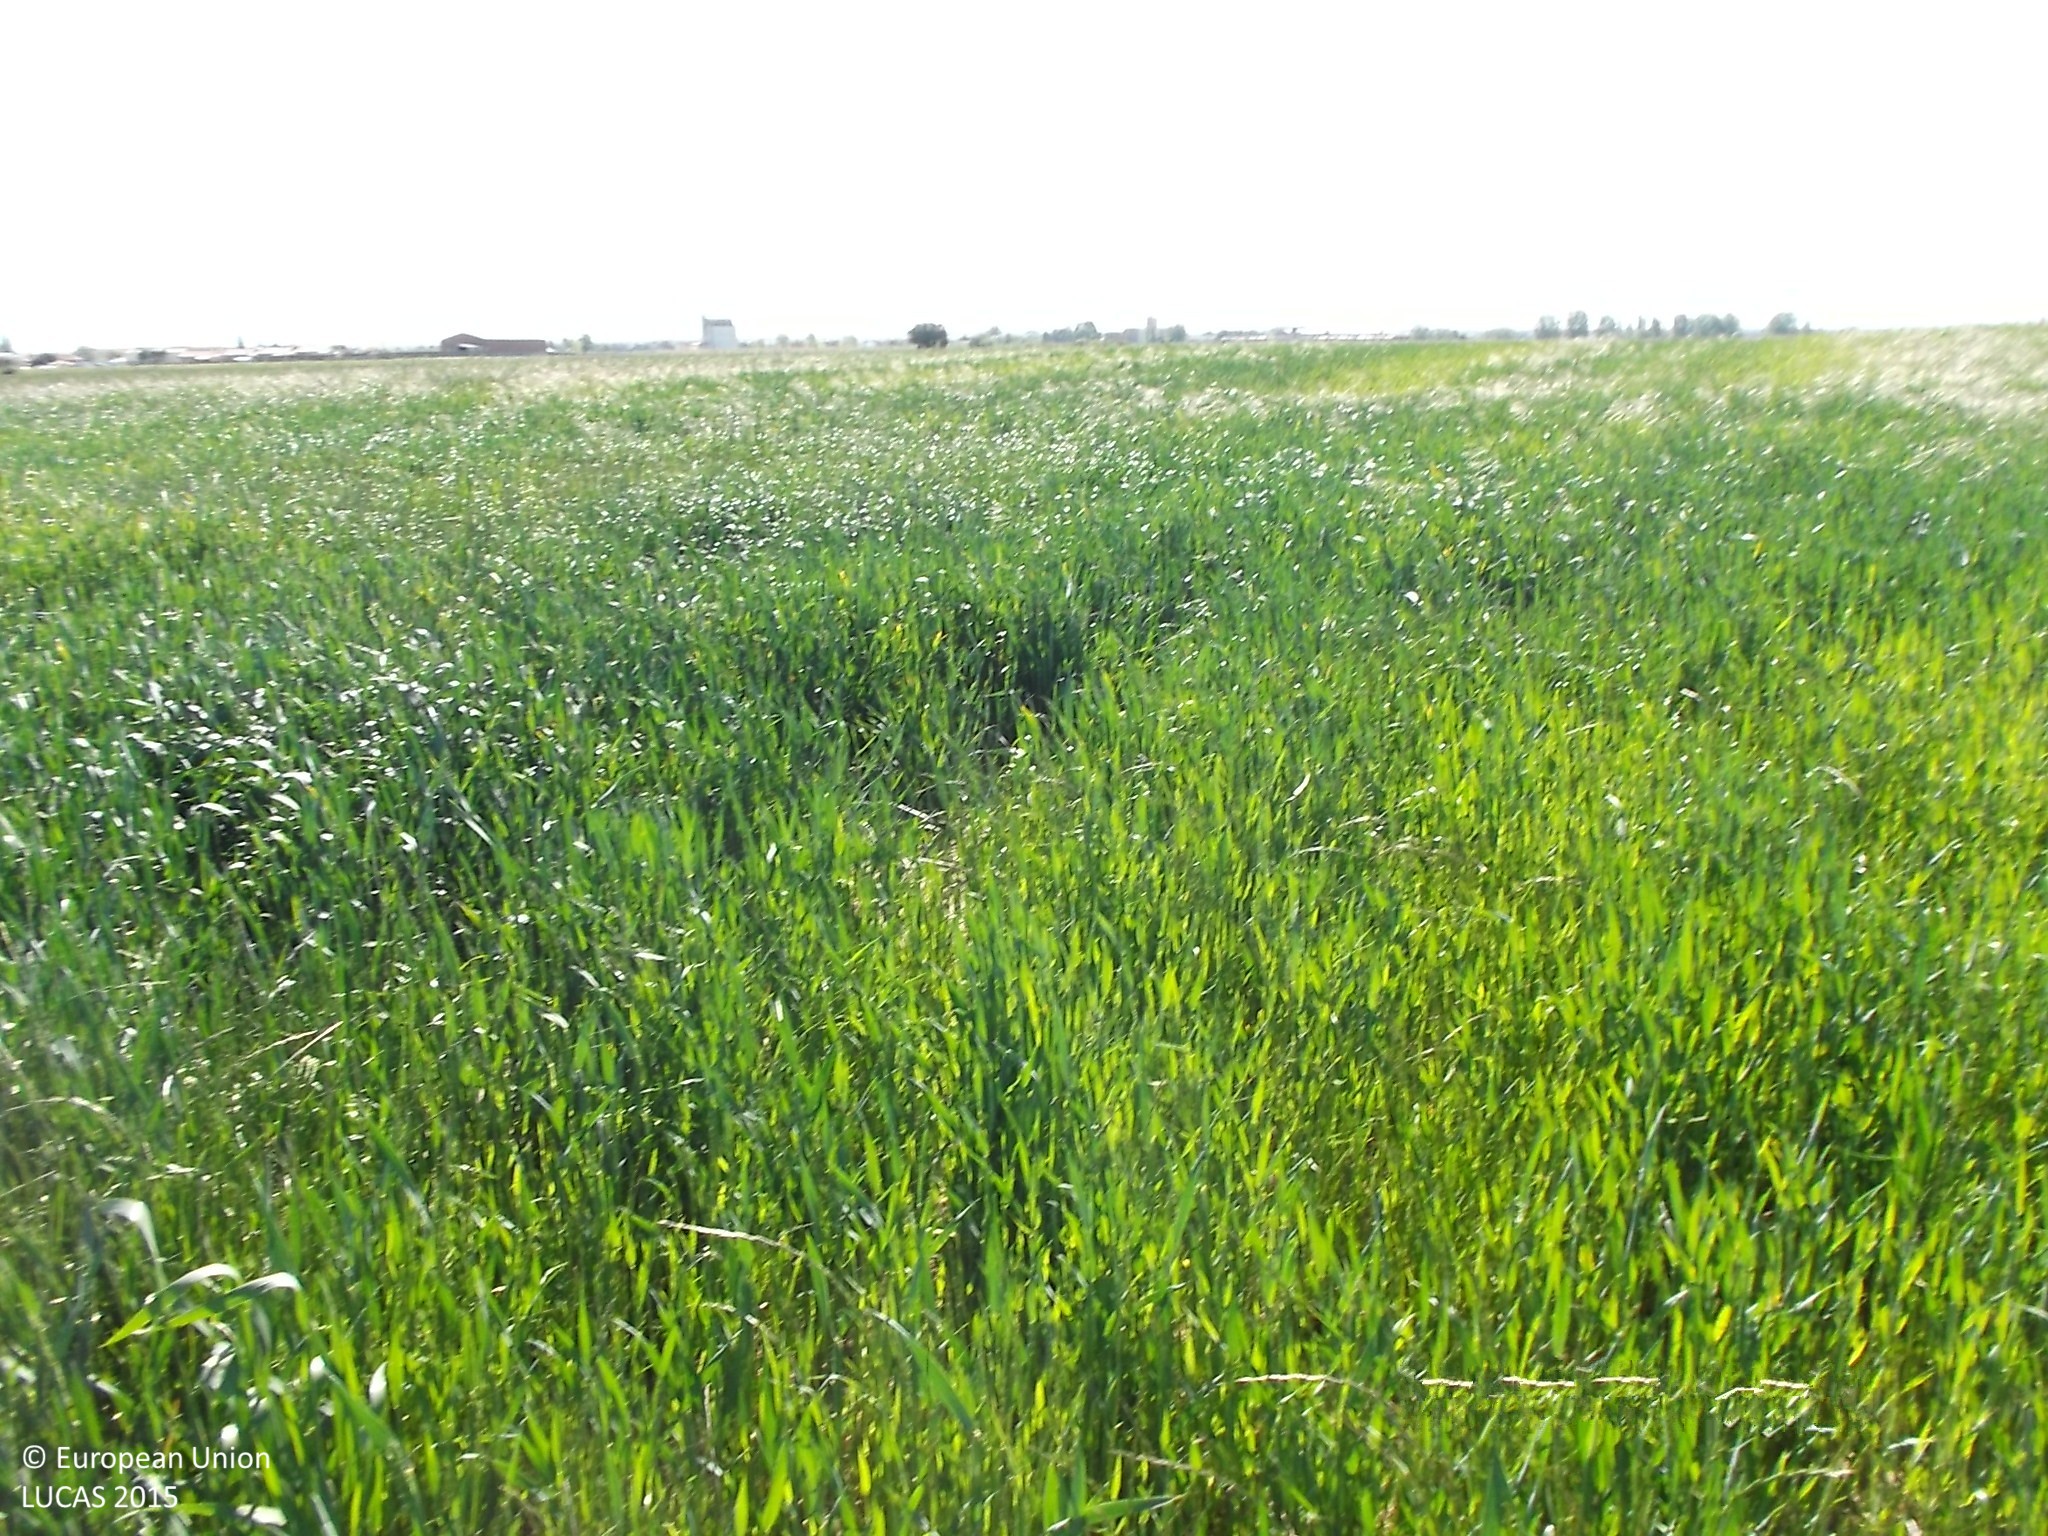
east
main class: Cropland
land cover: Mixed cereals for fodder
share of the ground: > 75 %
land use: Agriculture (excluding fallow land and kitchen gardens)
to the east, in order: Mixed cereals for fodder; Grass margins; Fences; Grassland without tree/shrub cover
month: May
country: ES
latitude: 40.7956
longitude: -6.2650
